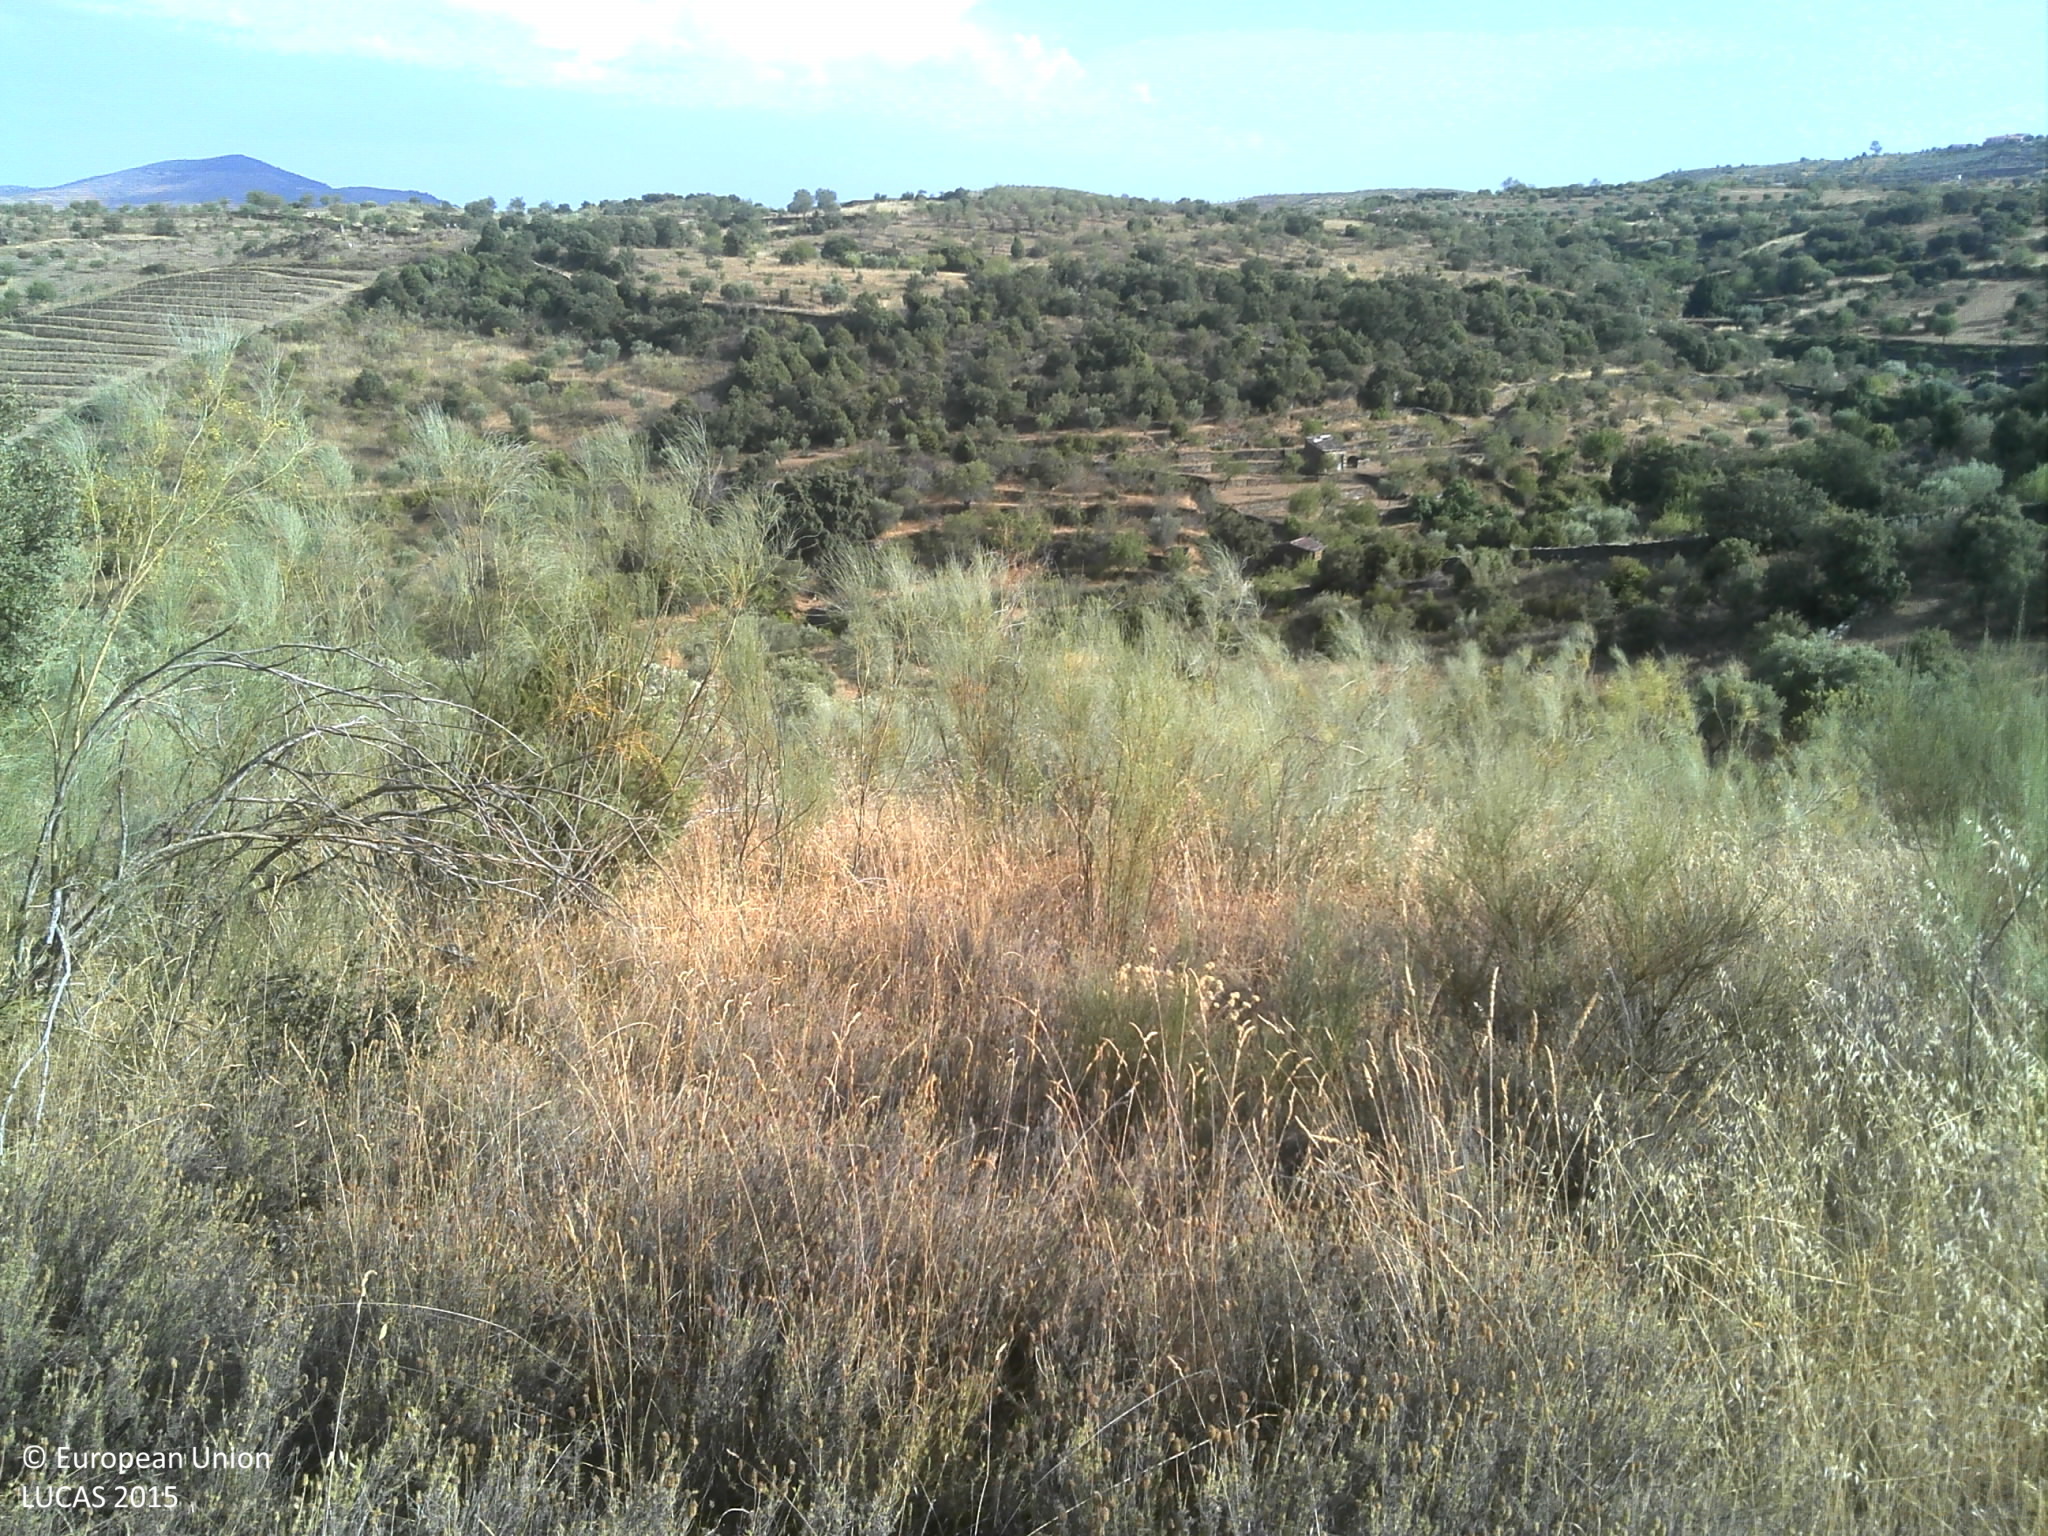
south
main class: Shrubland
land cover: Shrubland with sparse tree cover
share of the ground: > 75 %
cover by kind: shrubs 75 %, herbaceous plants 15 %, broadleaved forest trees 5 %, unconsolidated bare surface 5 %
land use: Abandoned areas
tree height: < 5 m
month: July
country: PT
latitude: 41.0909
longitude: -7.1233
